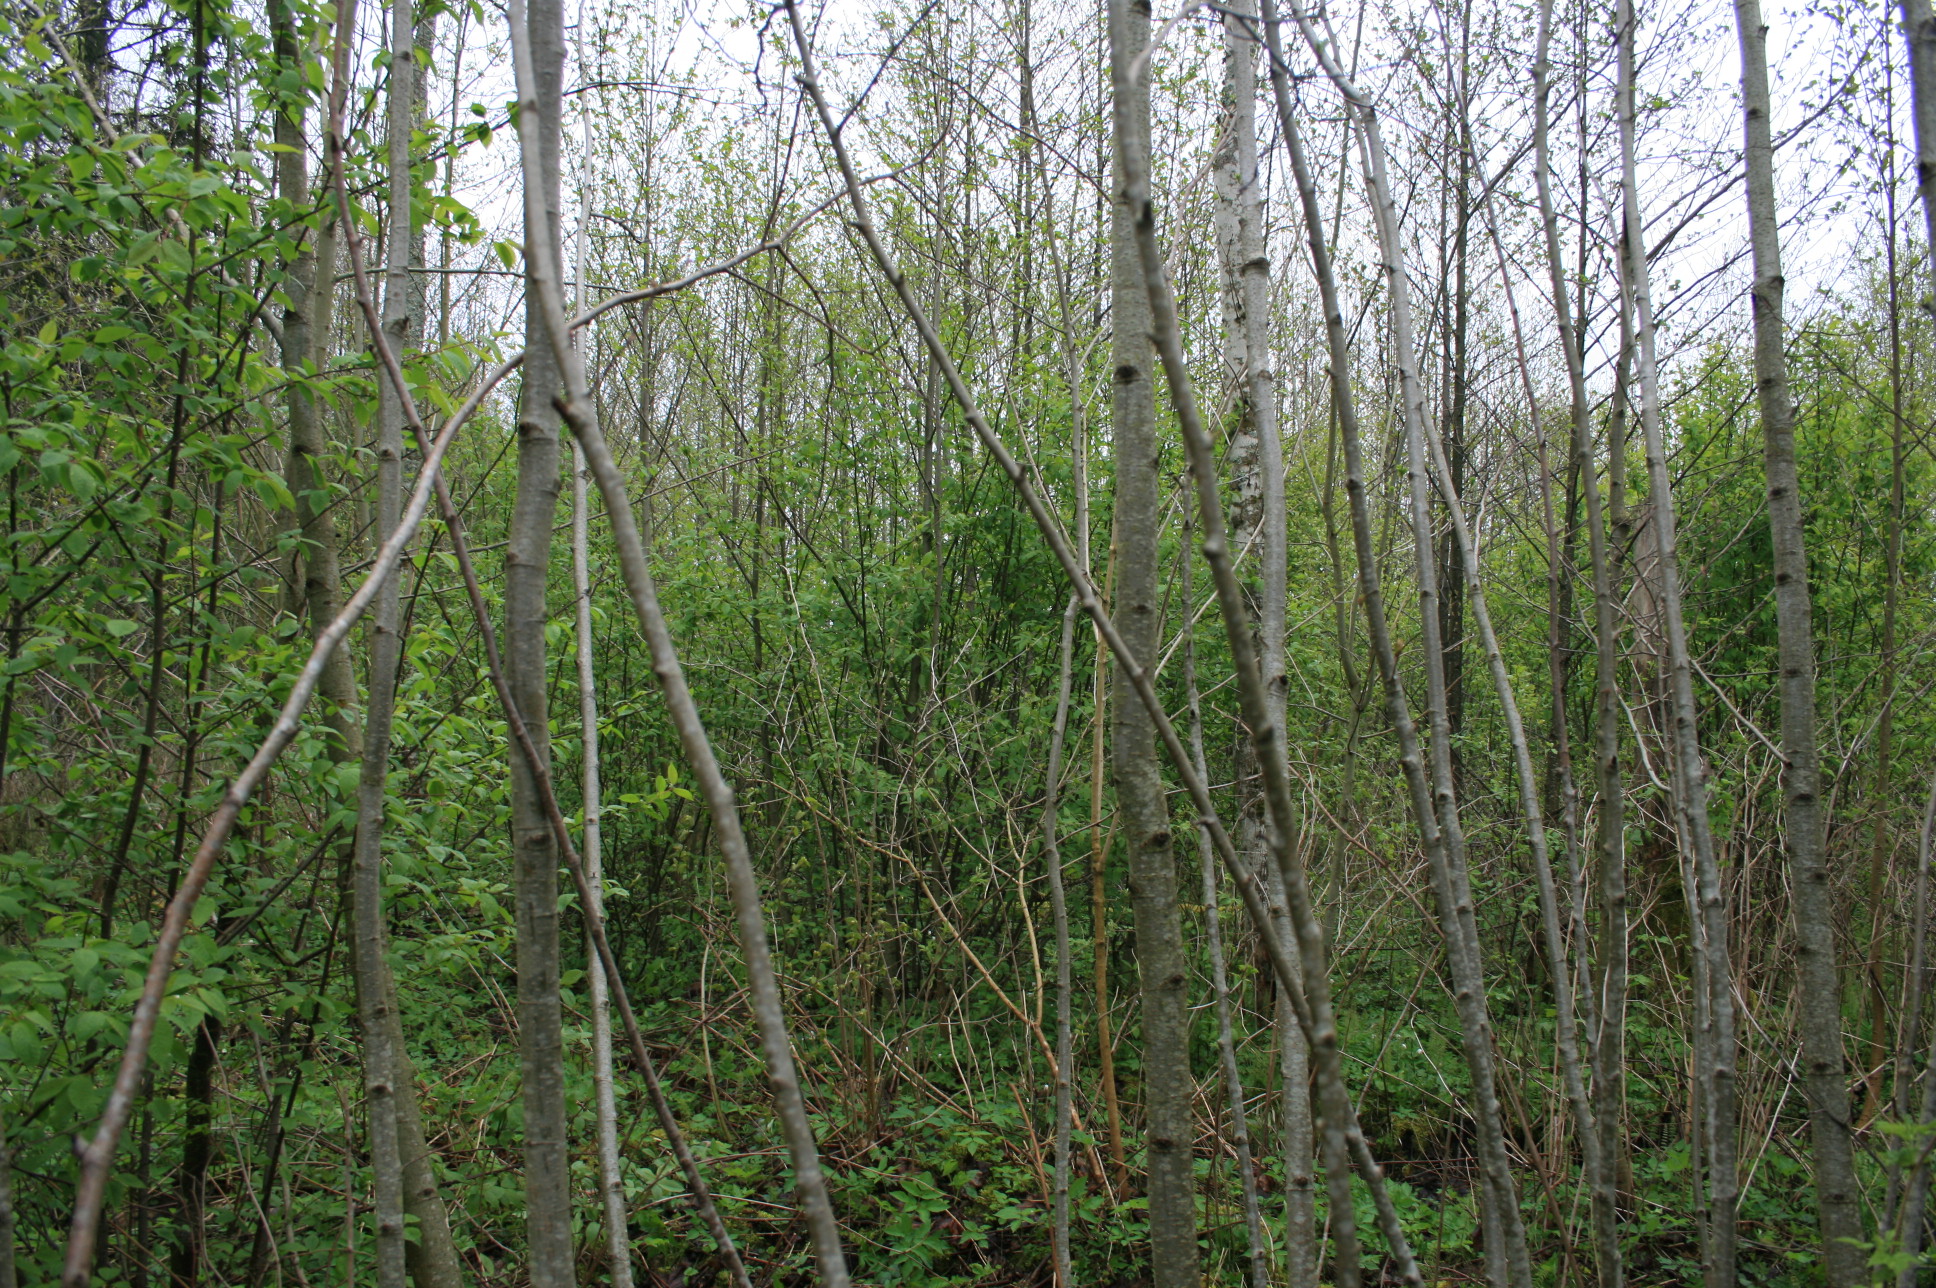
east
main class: Woodland
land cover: Broadleaved woodland
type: non-riverine alder, birch or aspen forest
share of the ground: 50 - 75 %
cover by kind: broadleaved forest trees 70 %, shrubs 20 %, herbaceous plants 10 %
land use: Forestry
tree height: > 5 m
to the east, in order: Broadleaved woodland; Ditches and canals; Broadleaved woodland; Grassland without tree/shrub cover; Common wheat
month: May
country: LT
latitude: 56.3758
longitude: 22.1150
